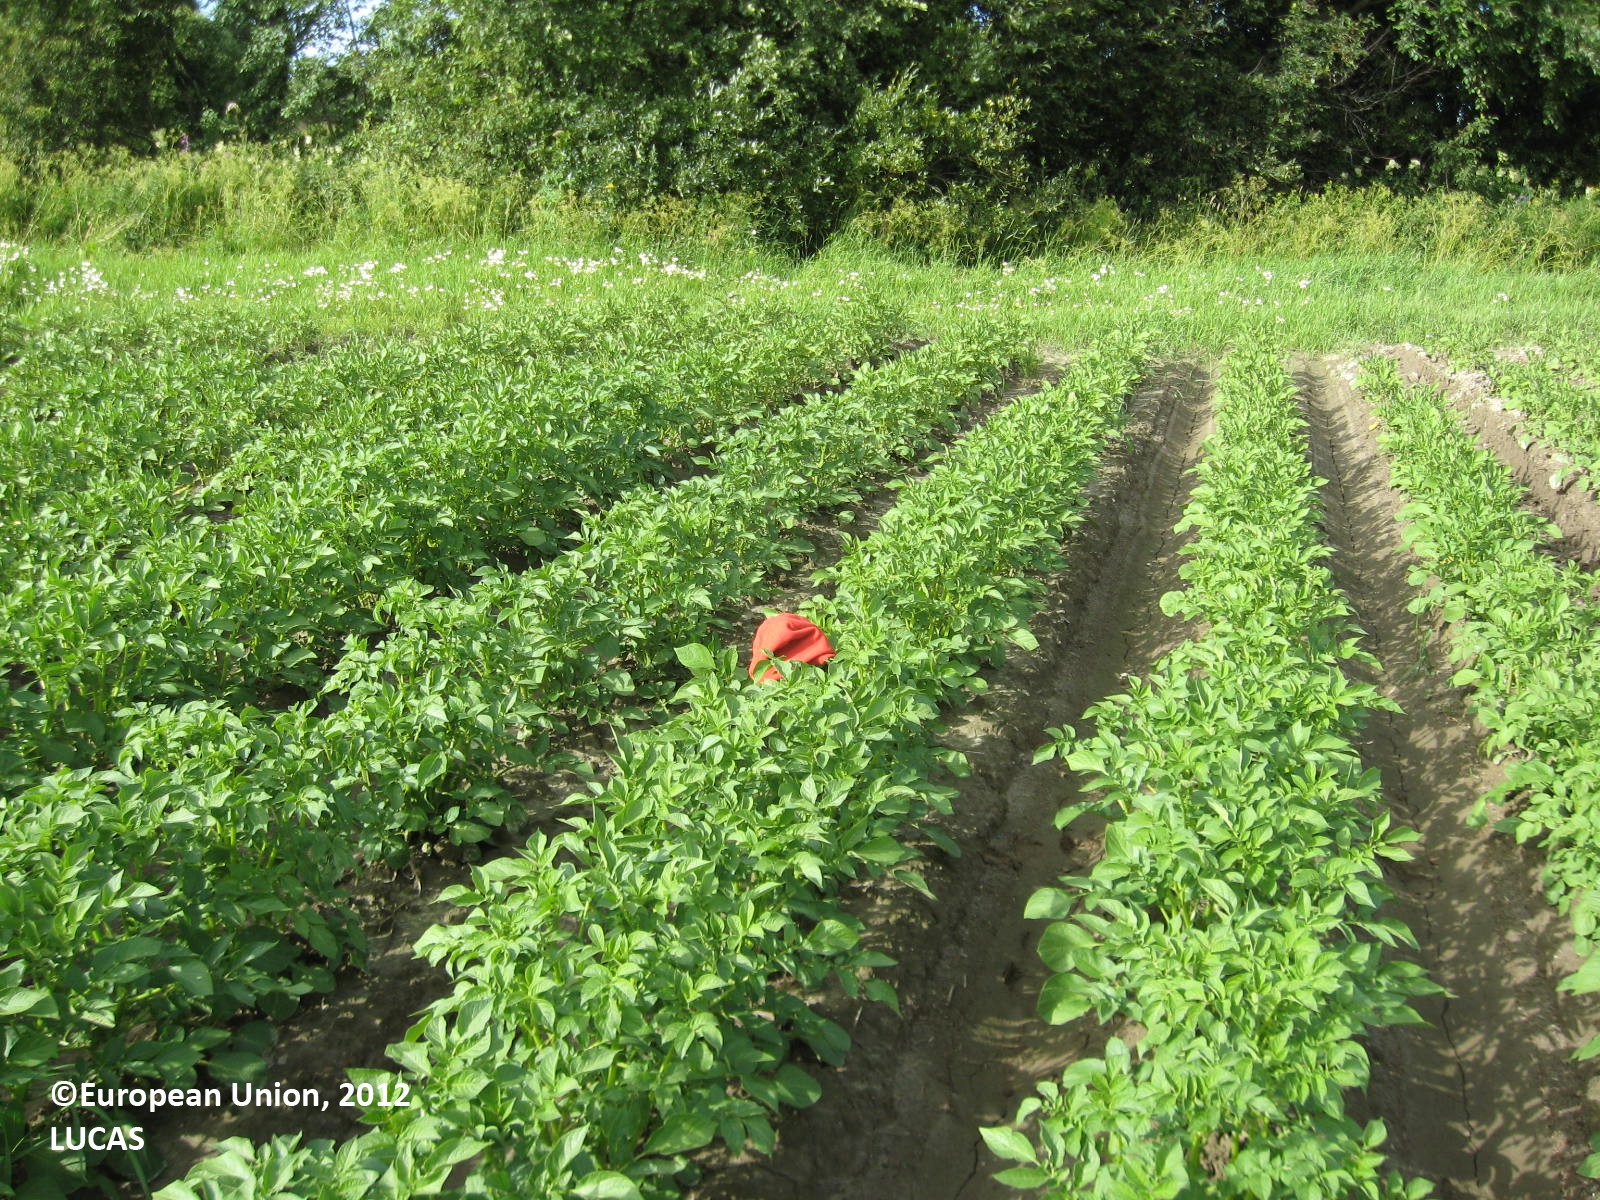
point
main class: Cropland
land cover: Potatoes
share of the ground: 50 - 75 %
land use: Agriculture (excluding fallow land and kitchen gardens)
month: July
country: FI
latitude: 62.2583
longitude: 21.5420
